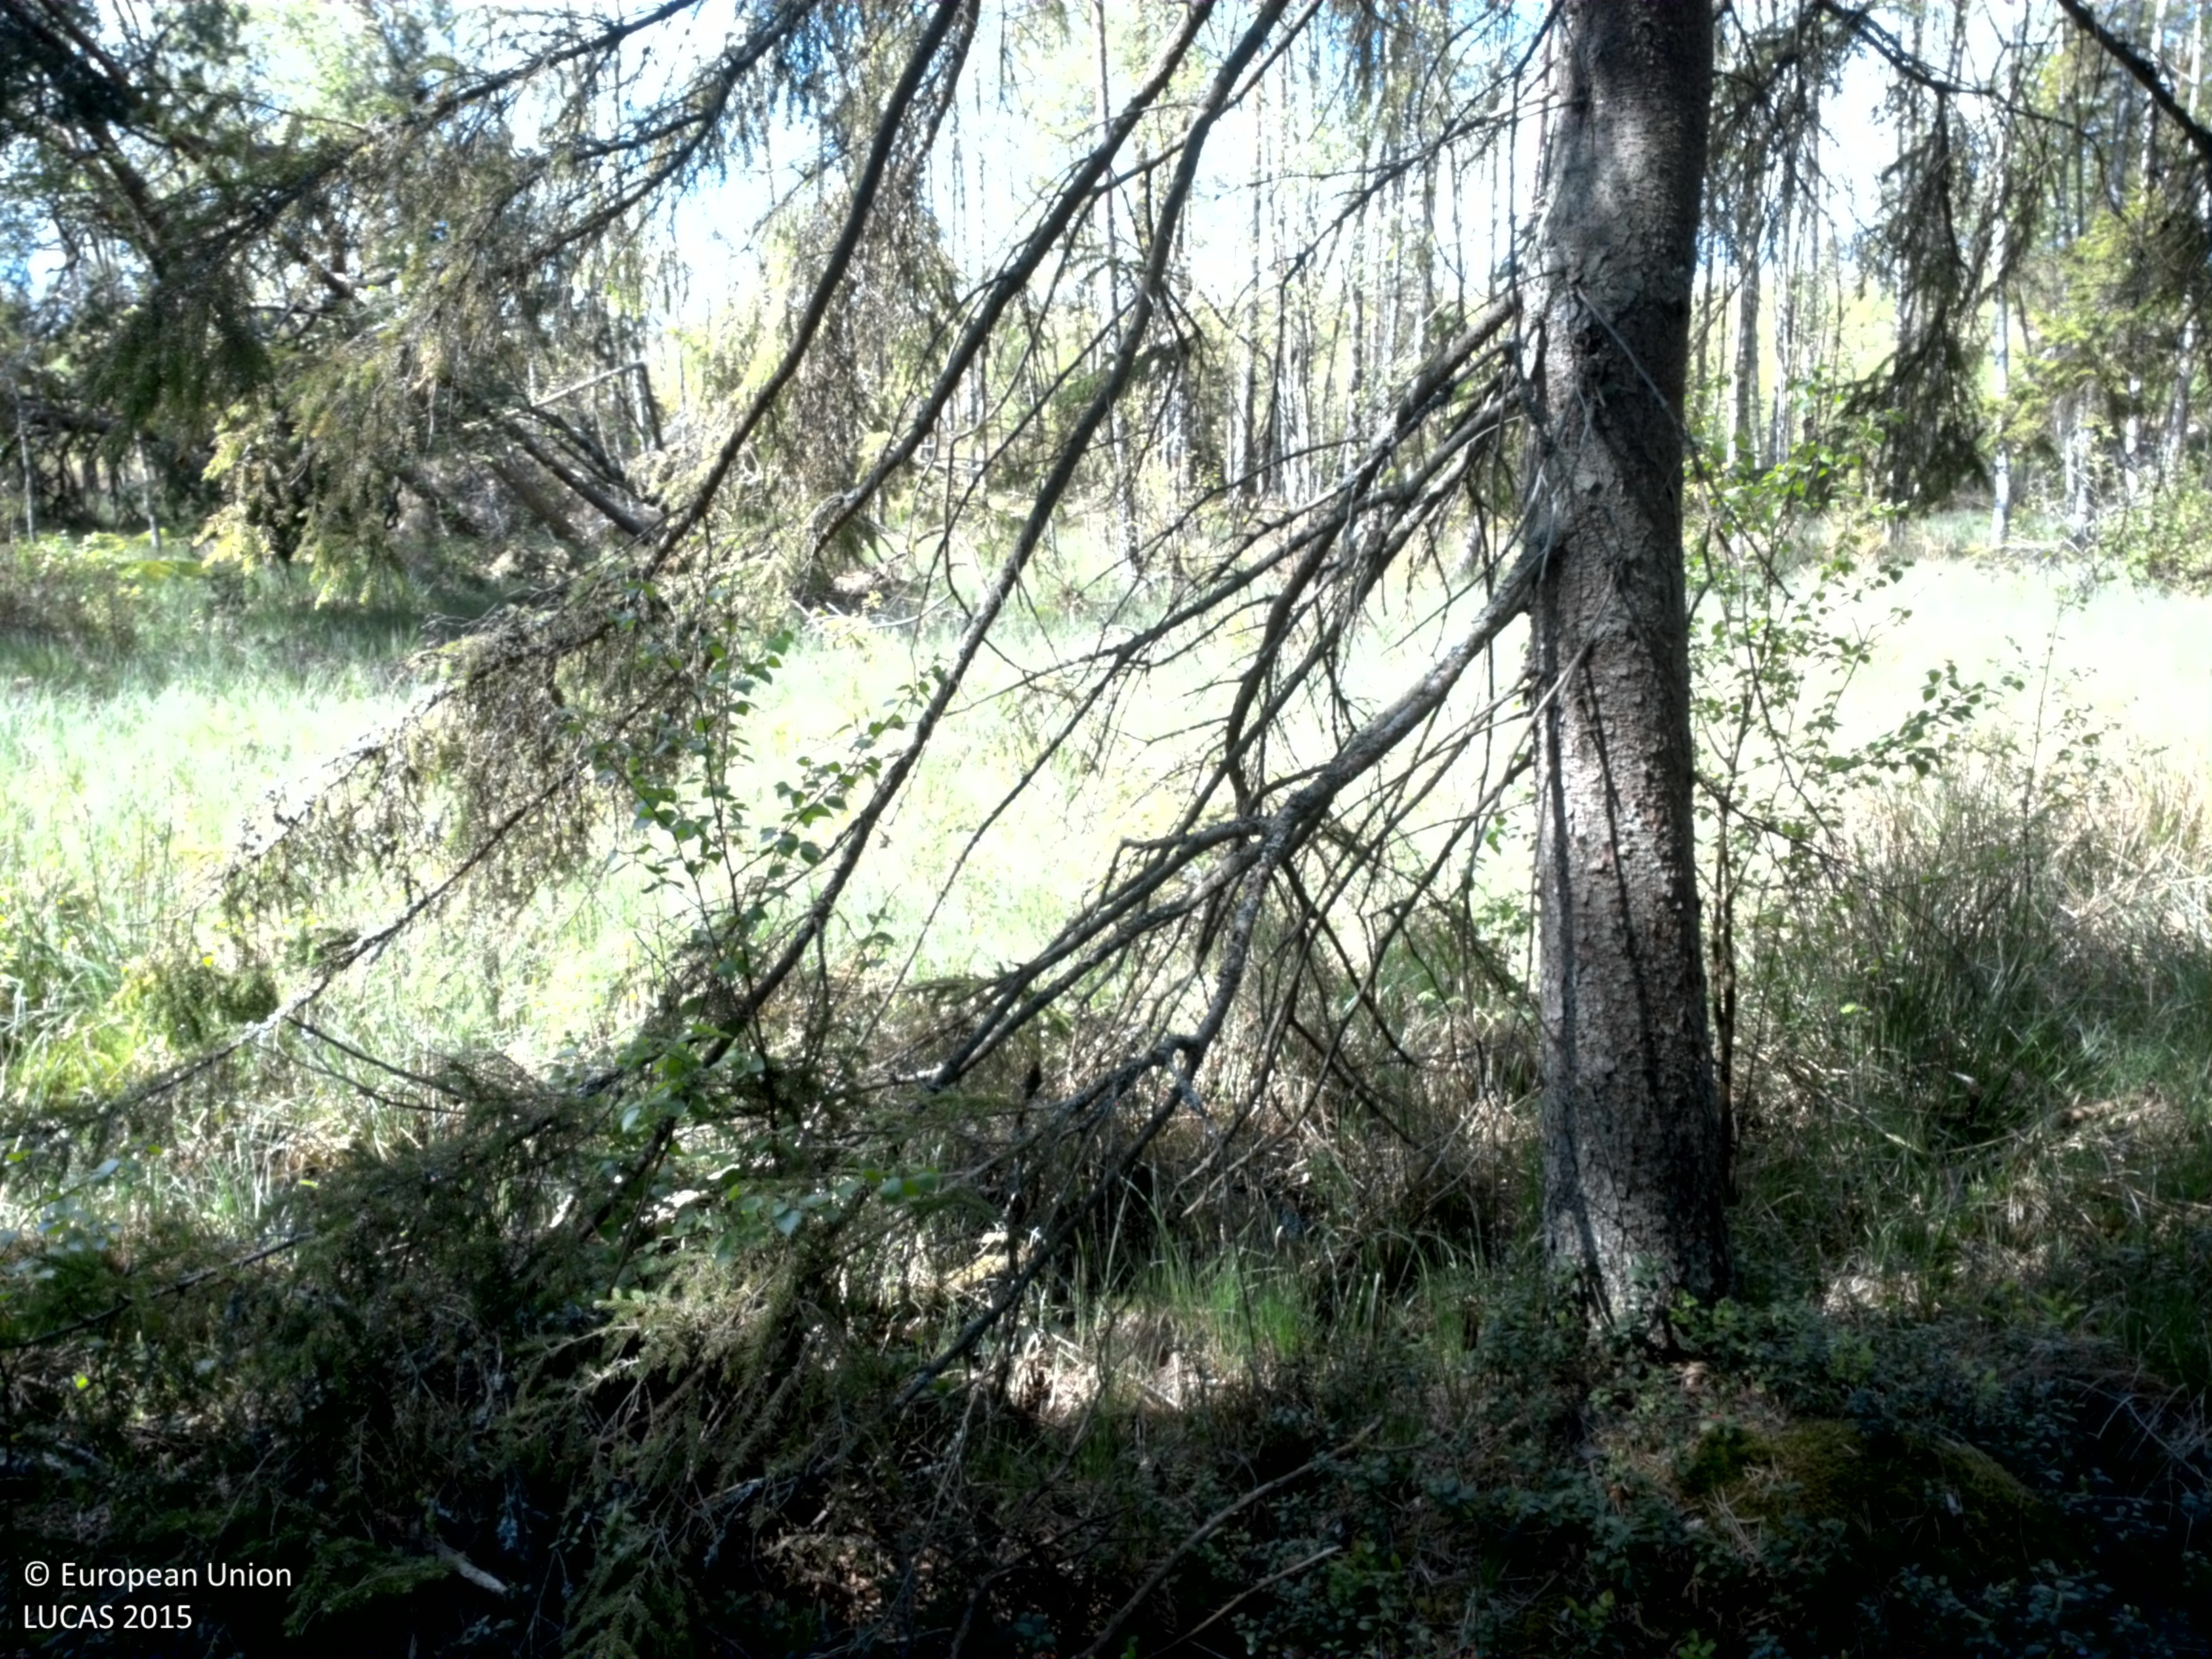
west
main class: Woodland
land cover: Spruce dominated coniferous woodland
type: boreal forest
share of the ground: > 75 %
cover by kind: coniferous forest trees 80 %, shrubs 10 %, herbaceous plants 5 %, lichens and mosses 5 %
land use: Forestry
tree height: > 5 m
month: May
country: SE
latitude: 56.5090
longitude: 15.3447
